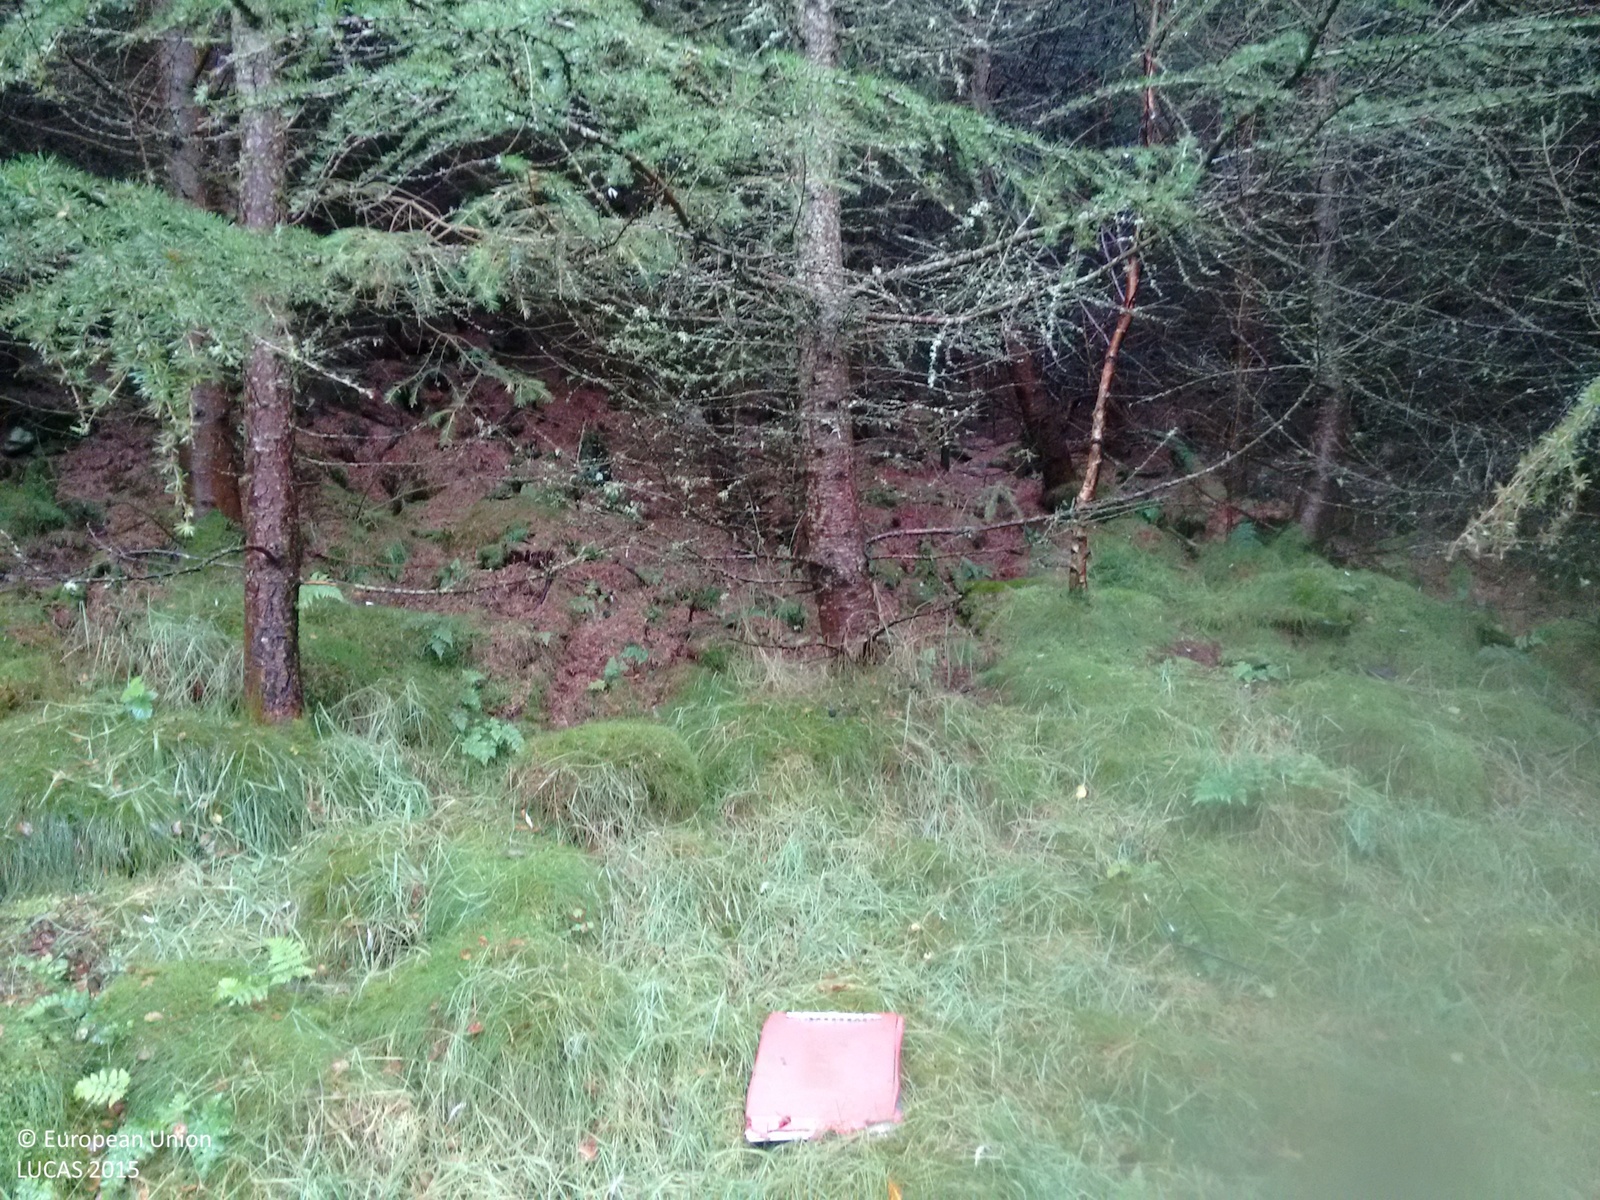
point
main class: Woodland
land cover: Spruce dominated mixed woodland
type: exotic forest
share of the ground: > 75 %
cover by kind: coniferous forest trees 60 %, broadleaved forest trees 35 %, herbaceous plants 5 %
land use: Forestry
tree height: > 5 m
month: August
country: GB
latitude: 57.4369
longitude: -2.2599
